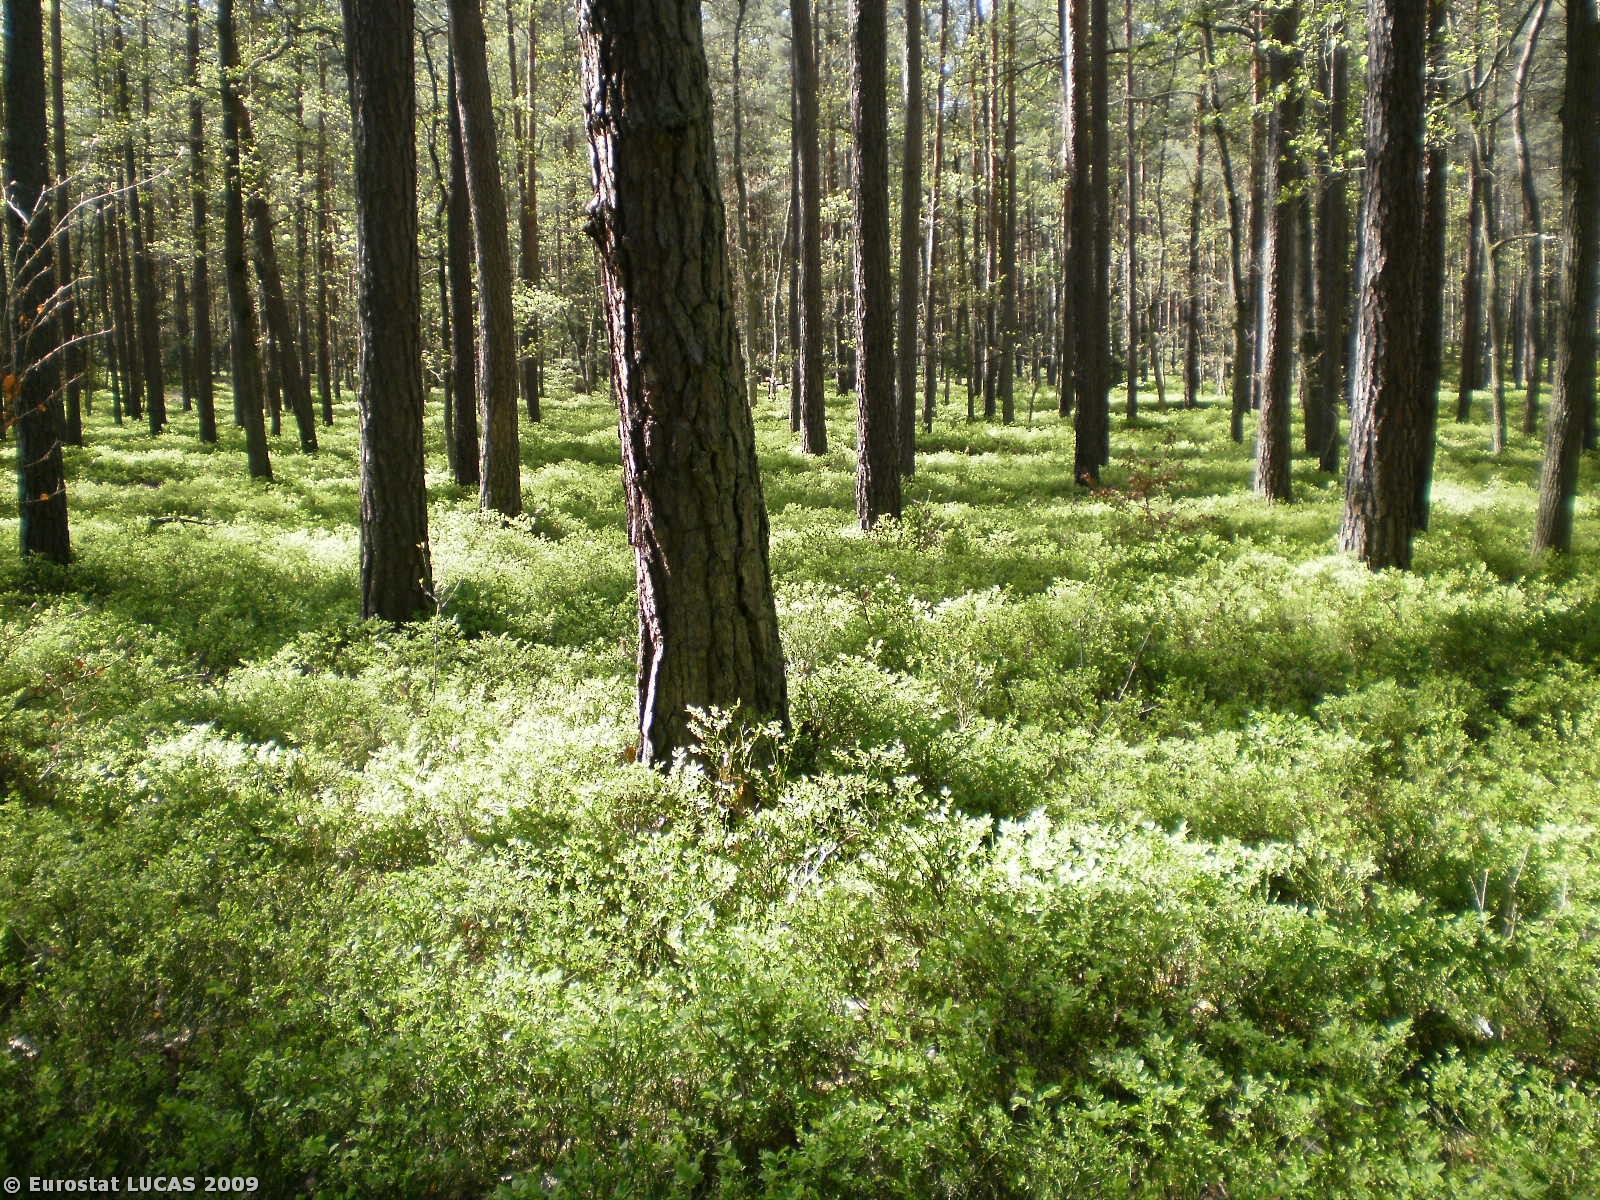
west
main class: Woodland
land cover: Coniferous woodland
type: hemiboreal forest and nemoral coniferous forest and mixed broadleaved-coniferous forest
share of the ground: > 75 %
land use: Forestry
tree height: > 5 m
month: January
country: PL
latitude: 53.9397
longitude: 18.9328
